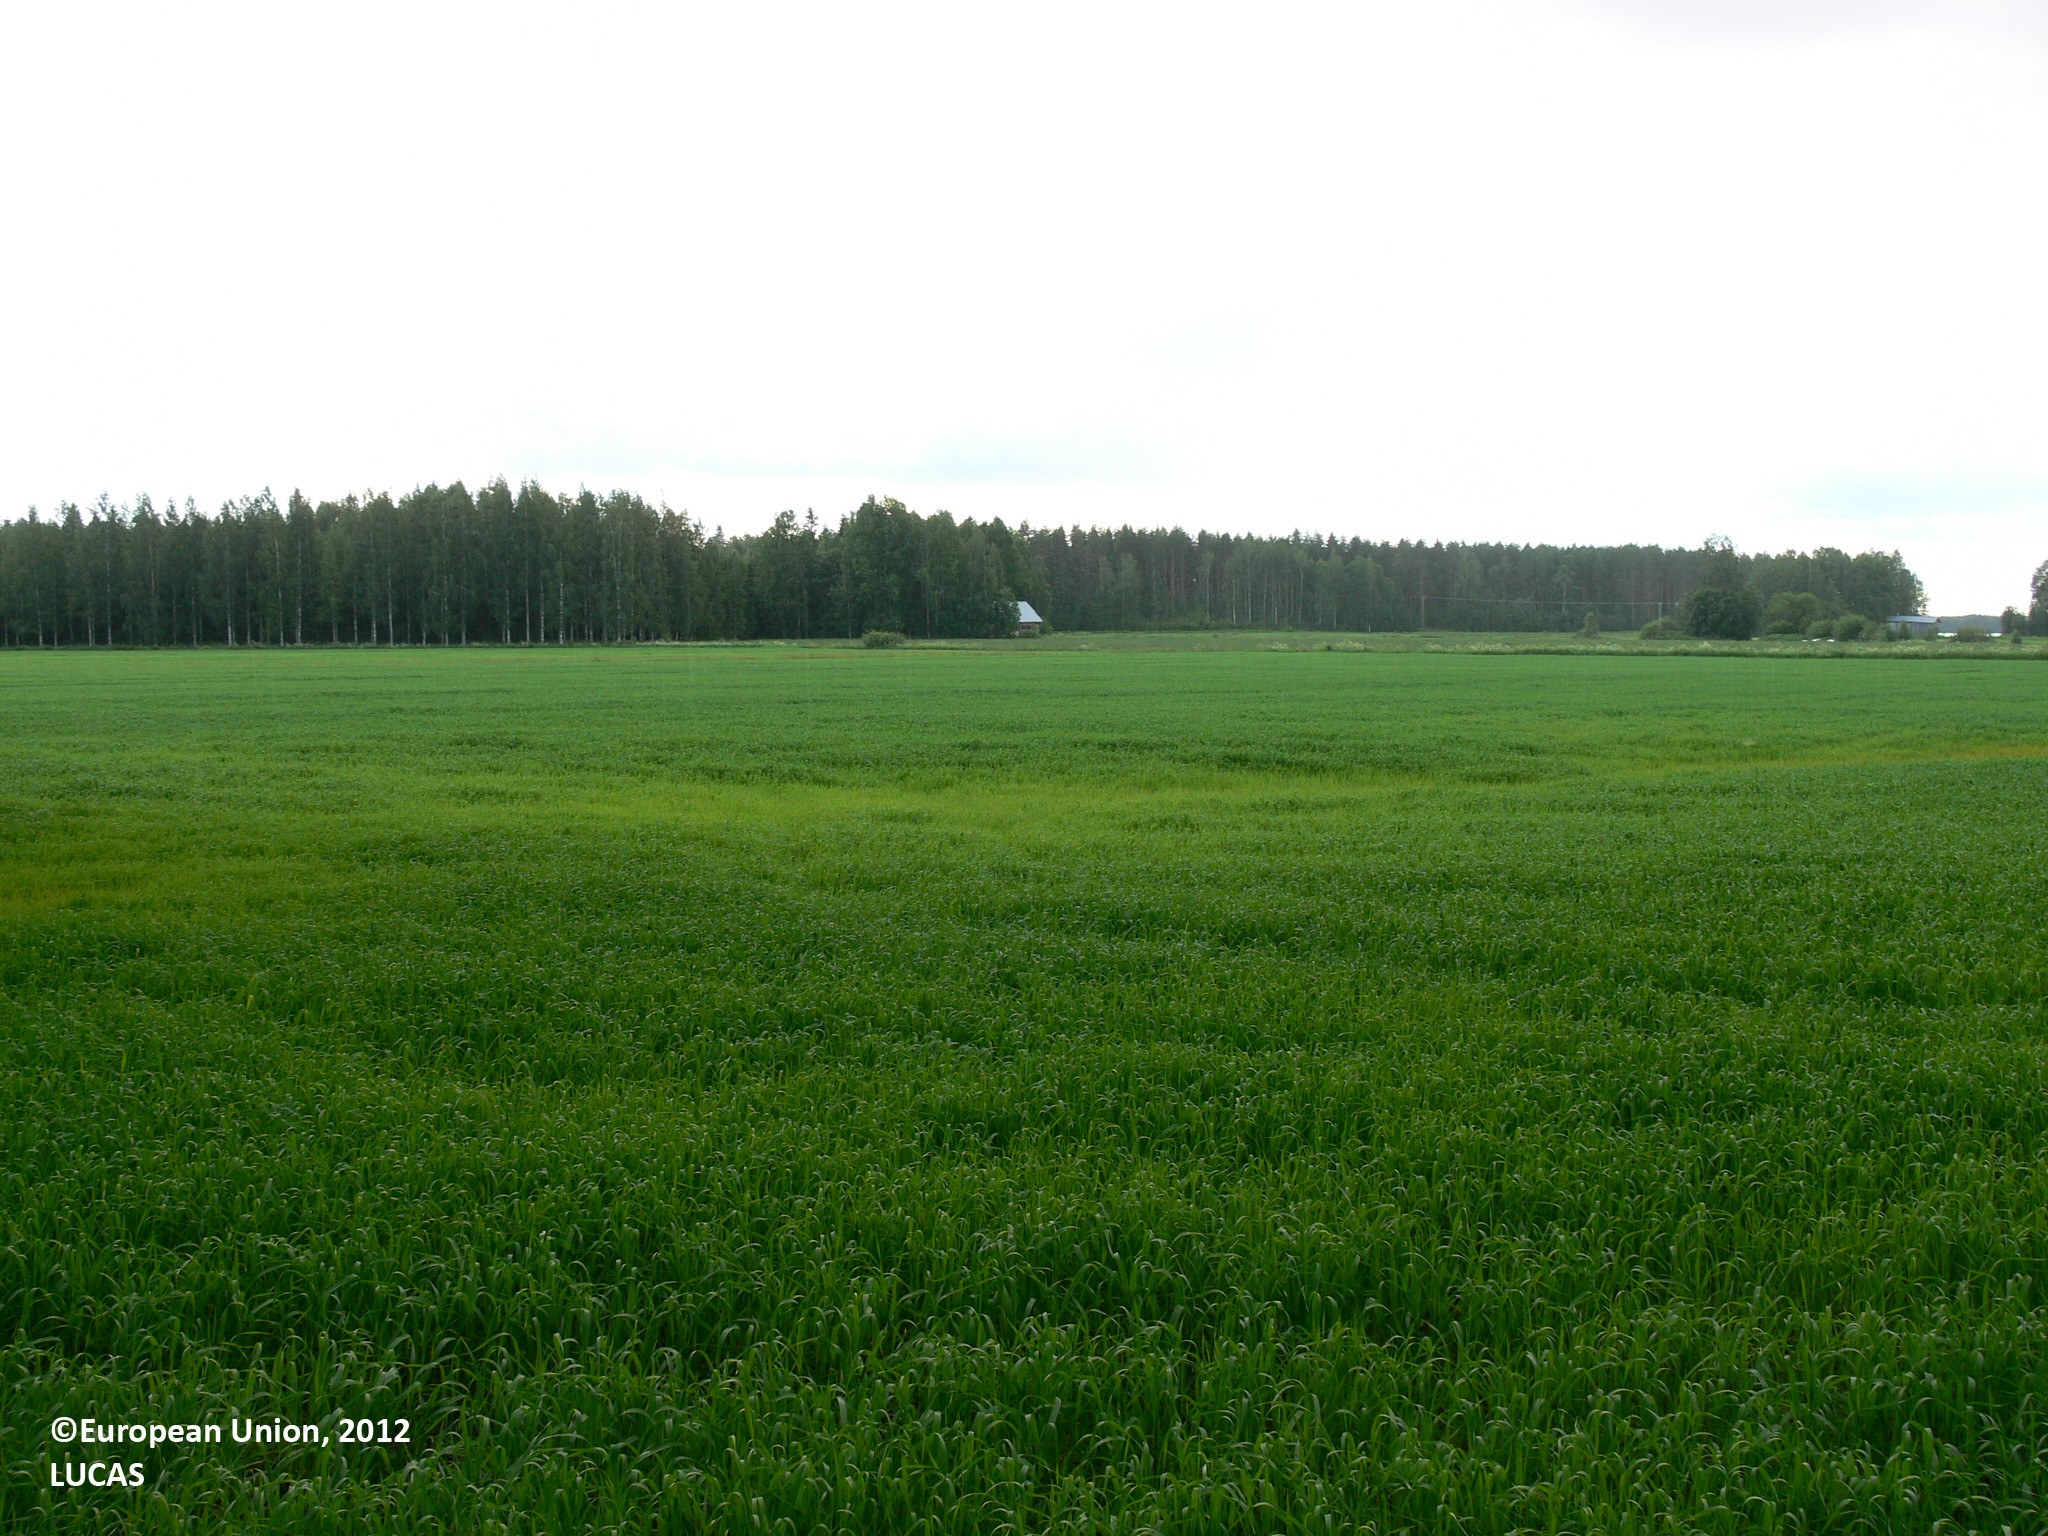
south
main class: Cropland
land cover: Oats
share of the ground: 50 - 75 %
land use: Agriculture (excluding fallow land and kitchen gardens)
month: June
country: FI
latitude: 62.4255
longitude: 29.5890
